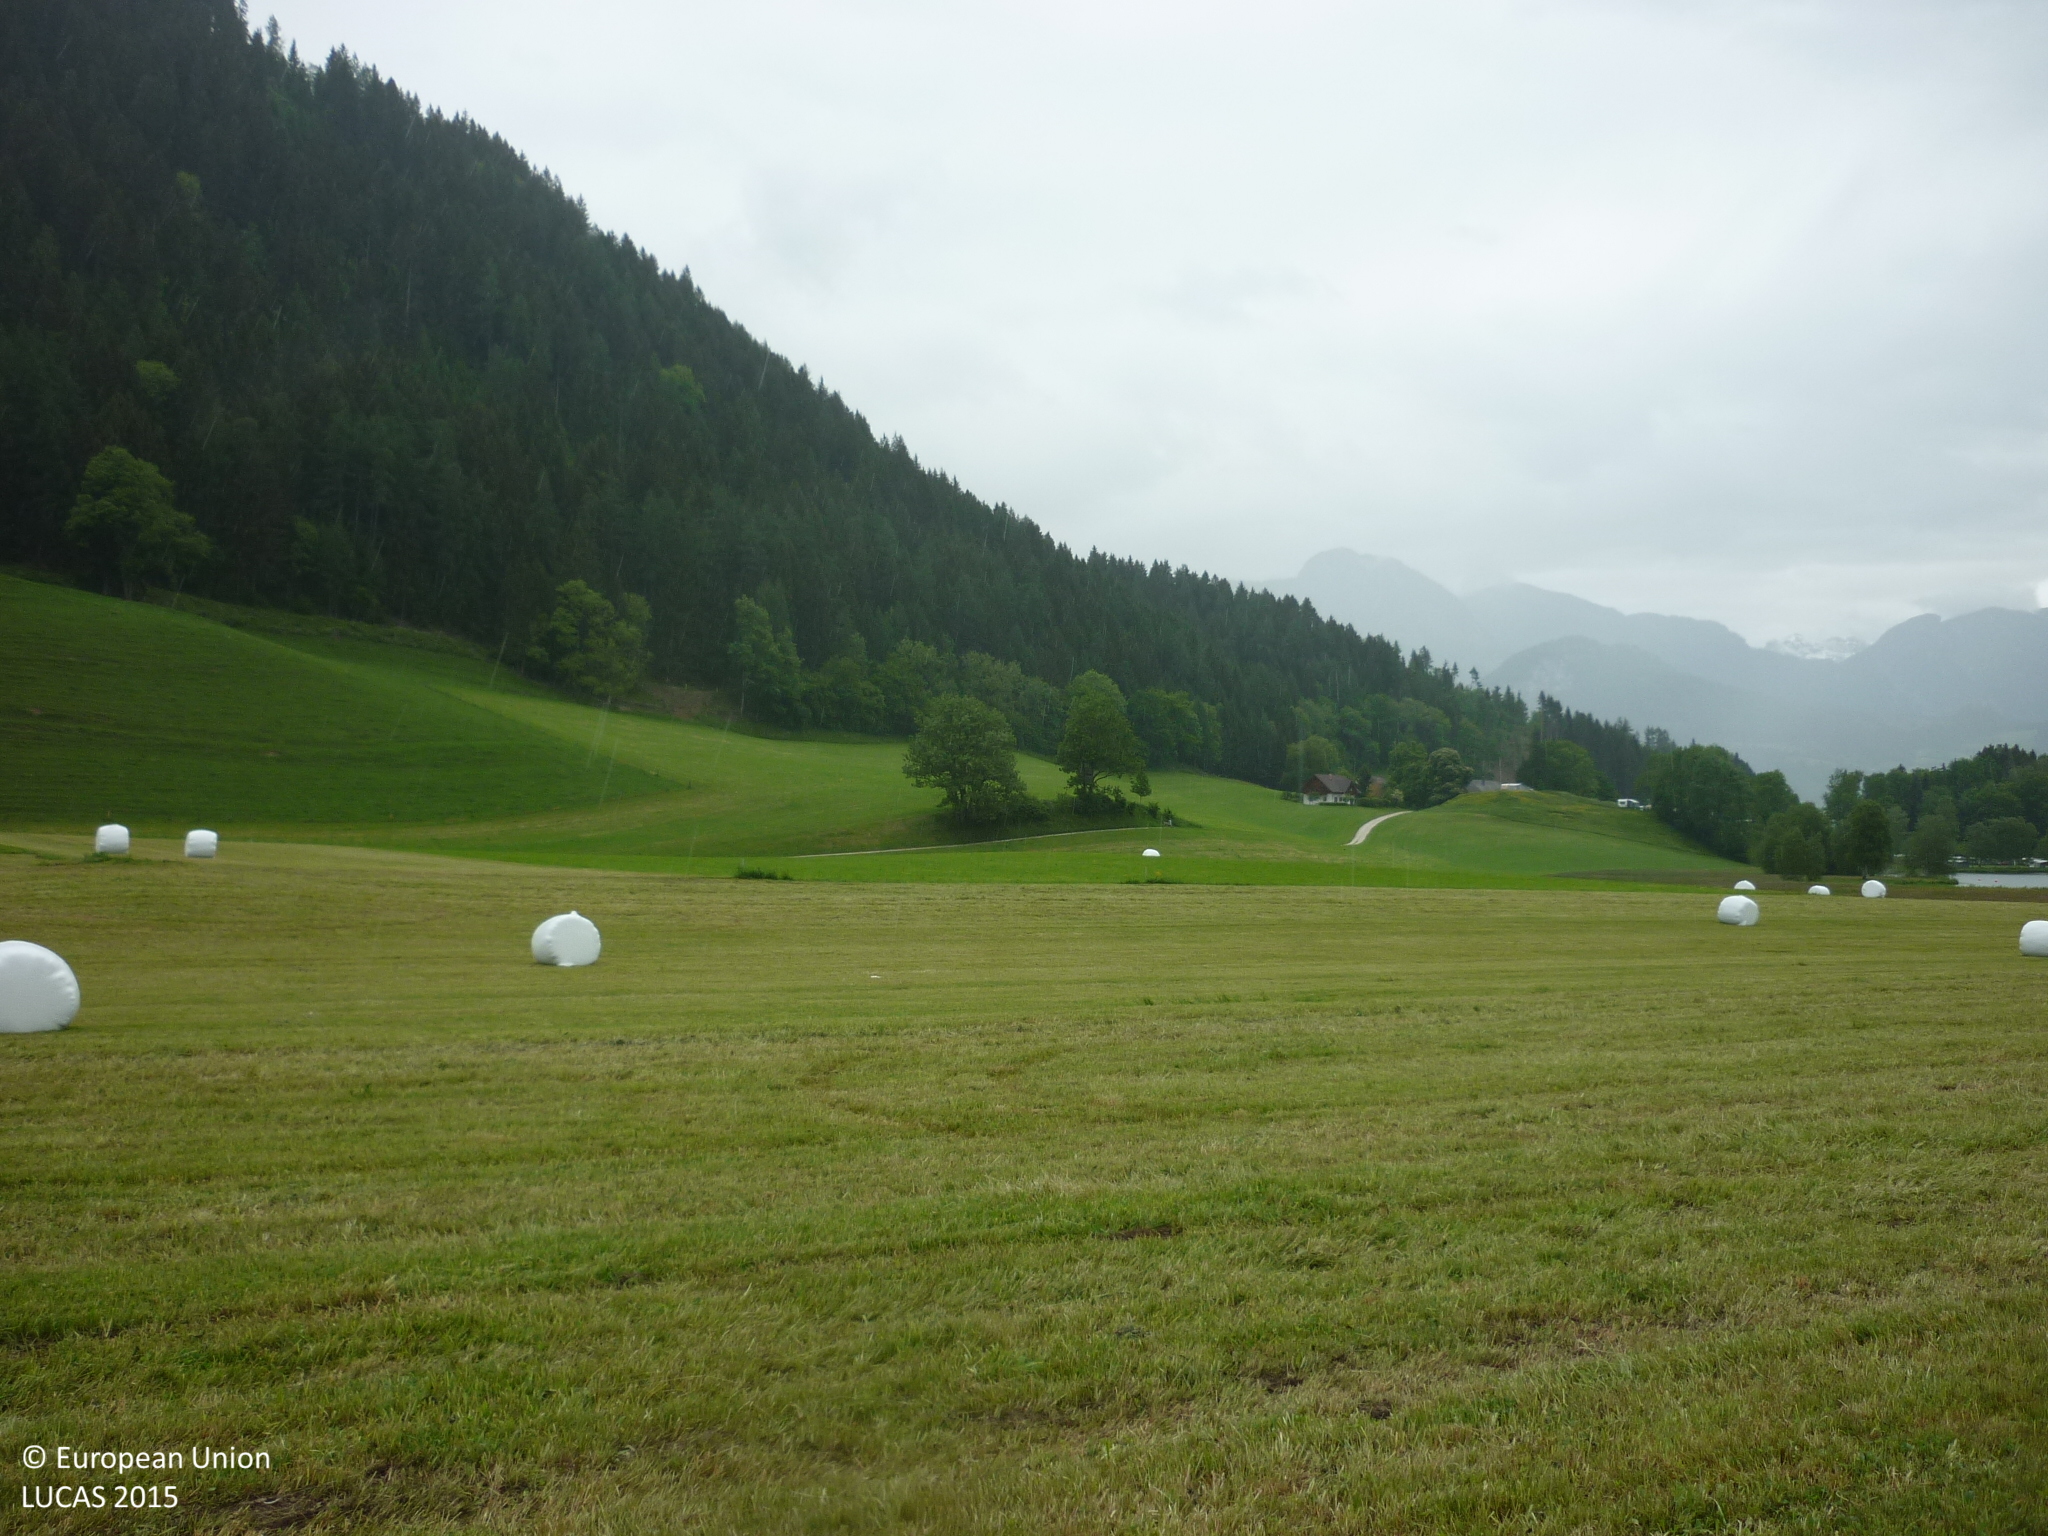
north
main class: Grassland
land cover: Grassland without tree/shrub cover
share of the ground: > 75 %
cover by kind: herbaceous plants 100 %
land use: Agriculture (excluding fallow land and kitchen gardens)
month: May
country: AT
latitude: 47.5155
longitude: 14.1286
